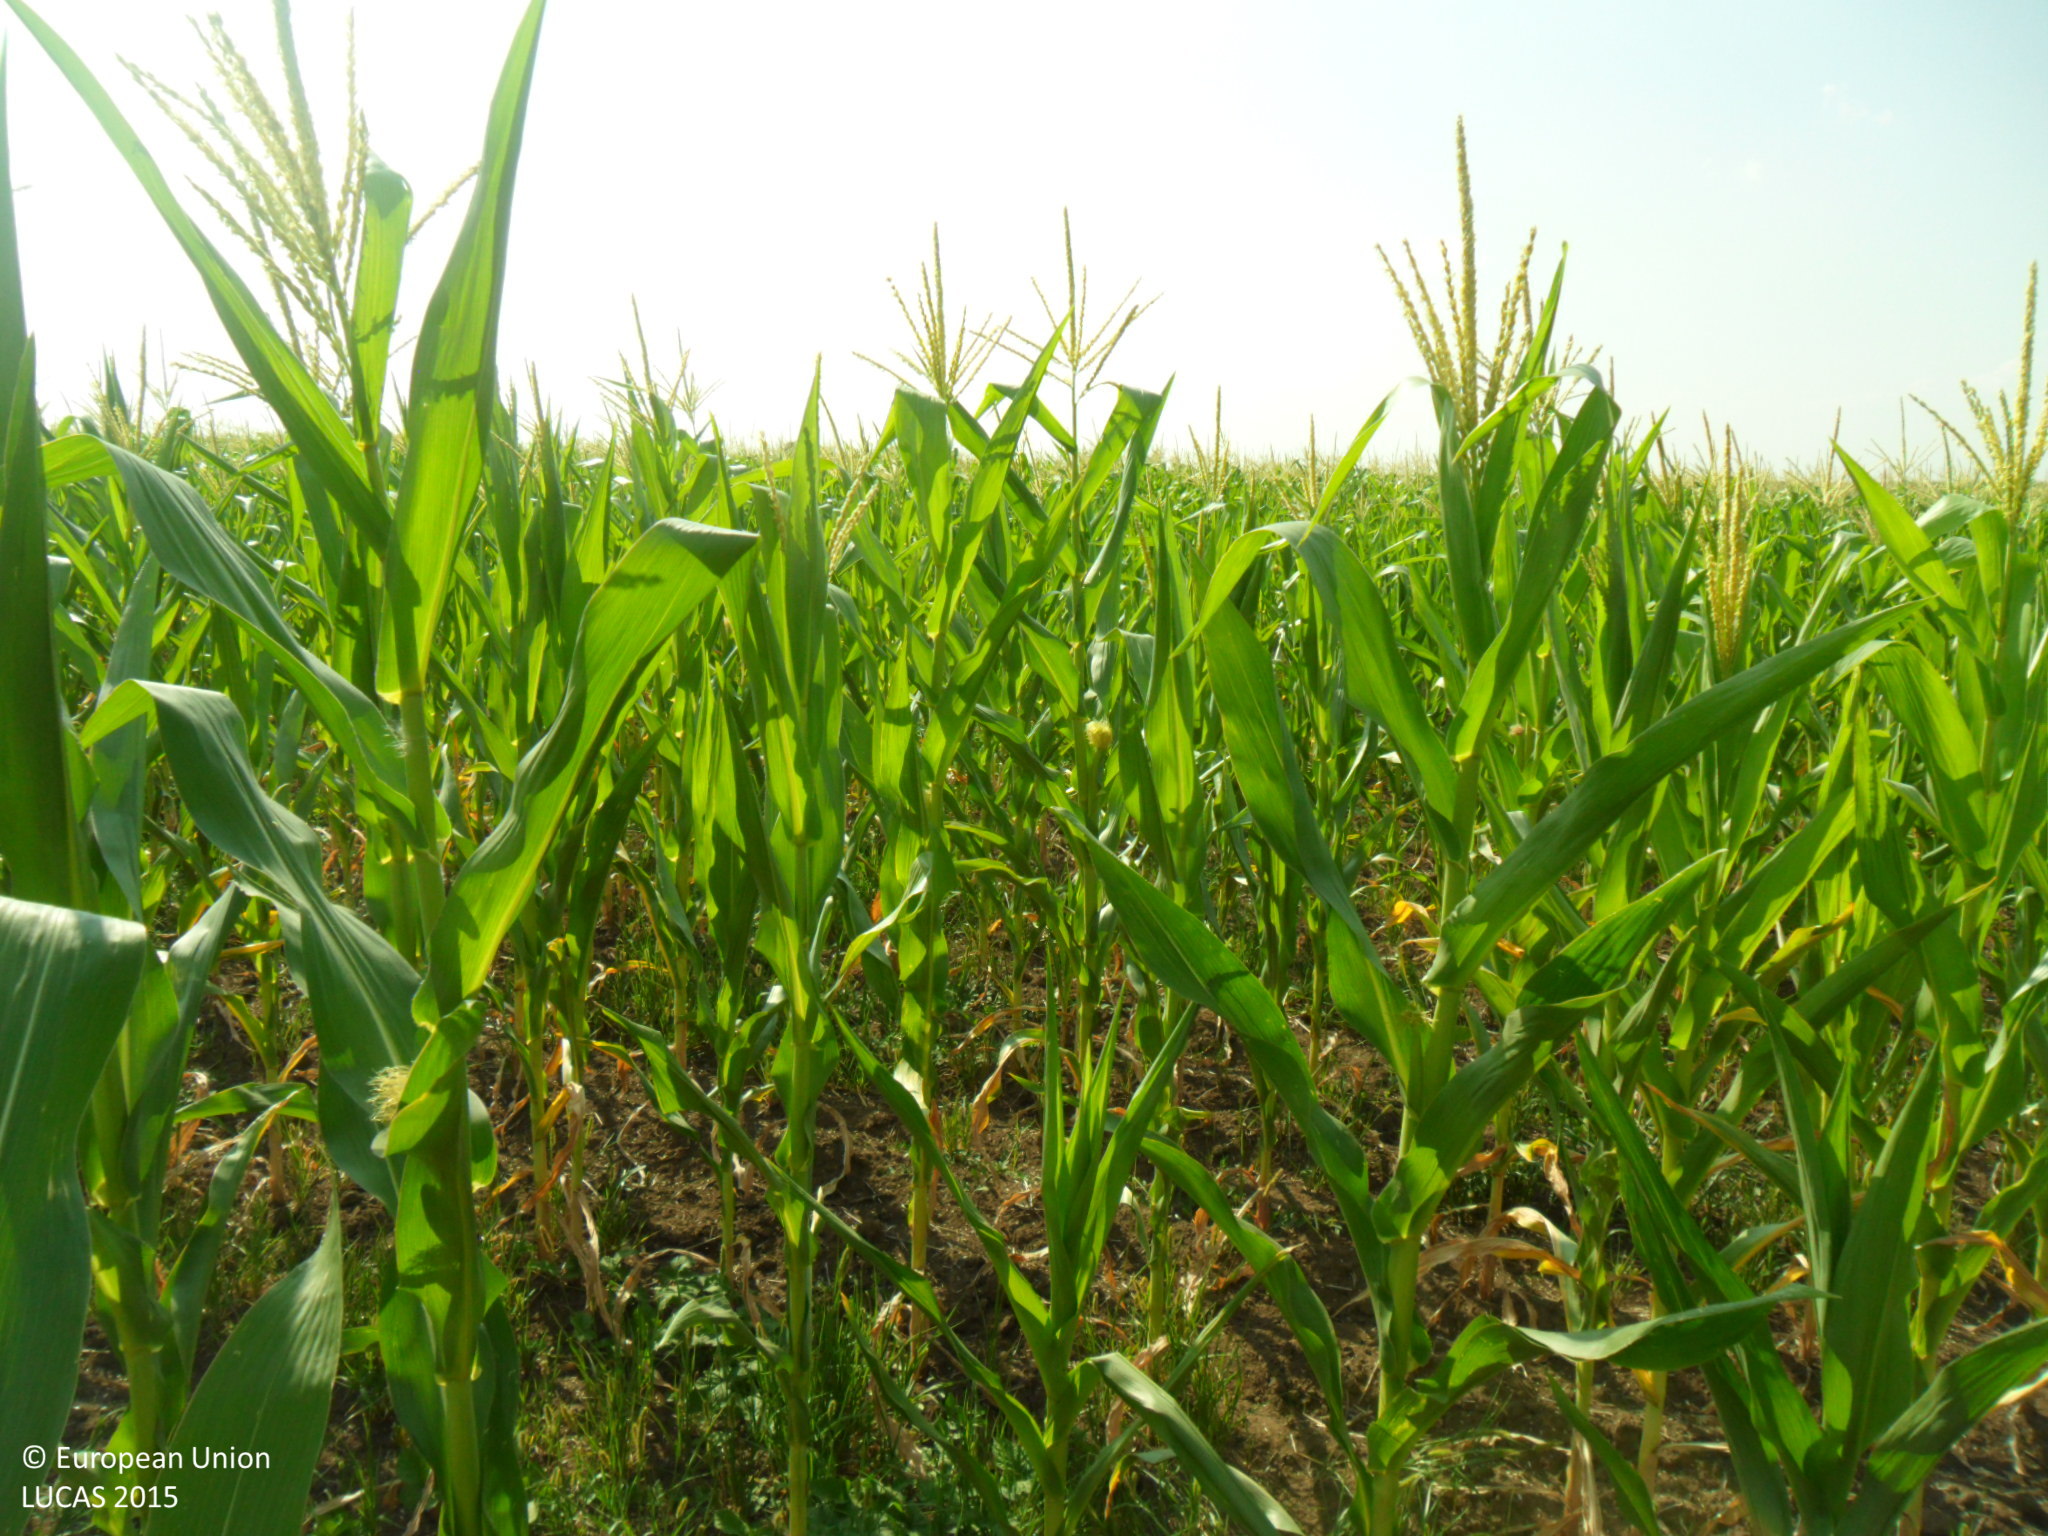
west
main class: Cropland
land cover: Maize
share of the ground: > 75 %
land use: Agriculture (excluding fallow land and kitchen gardens)
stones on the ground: < 10 %
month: July
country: BG
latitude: 43.6457
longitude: 27.0427
